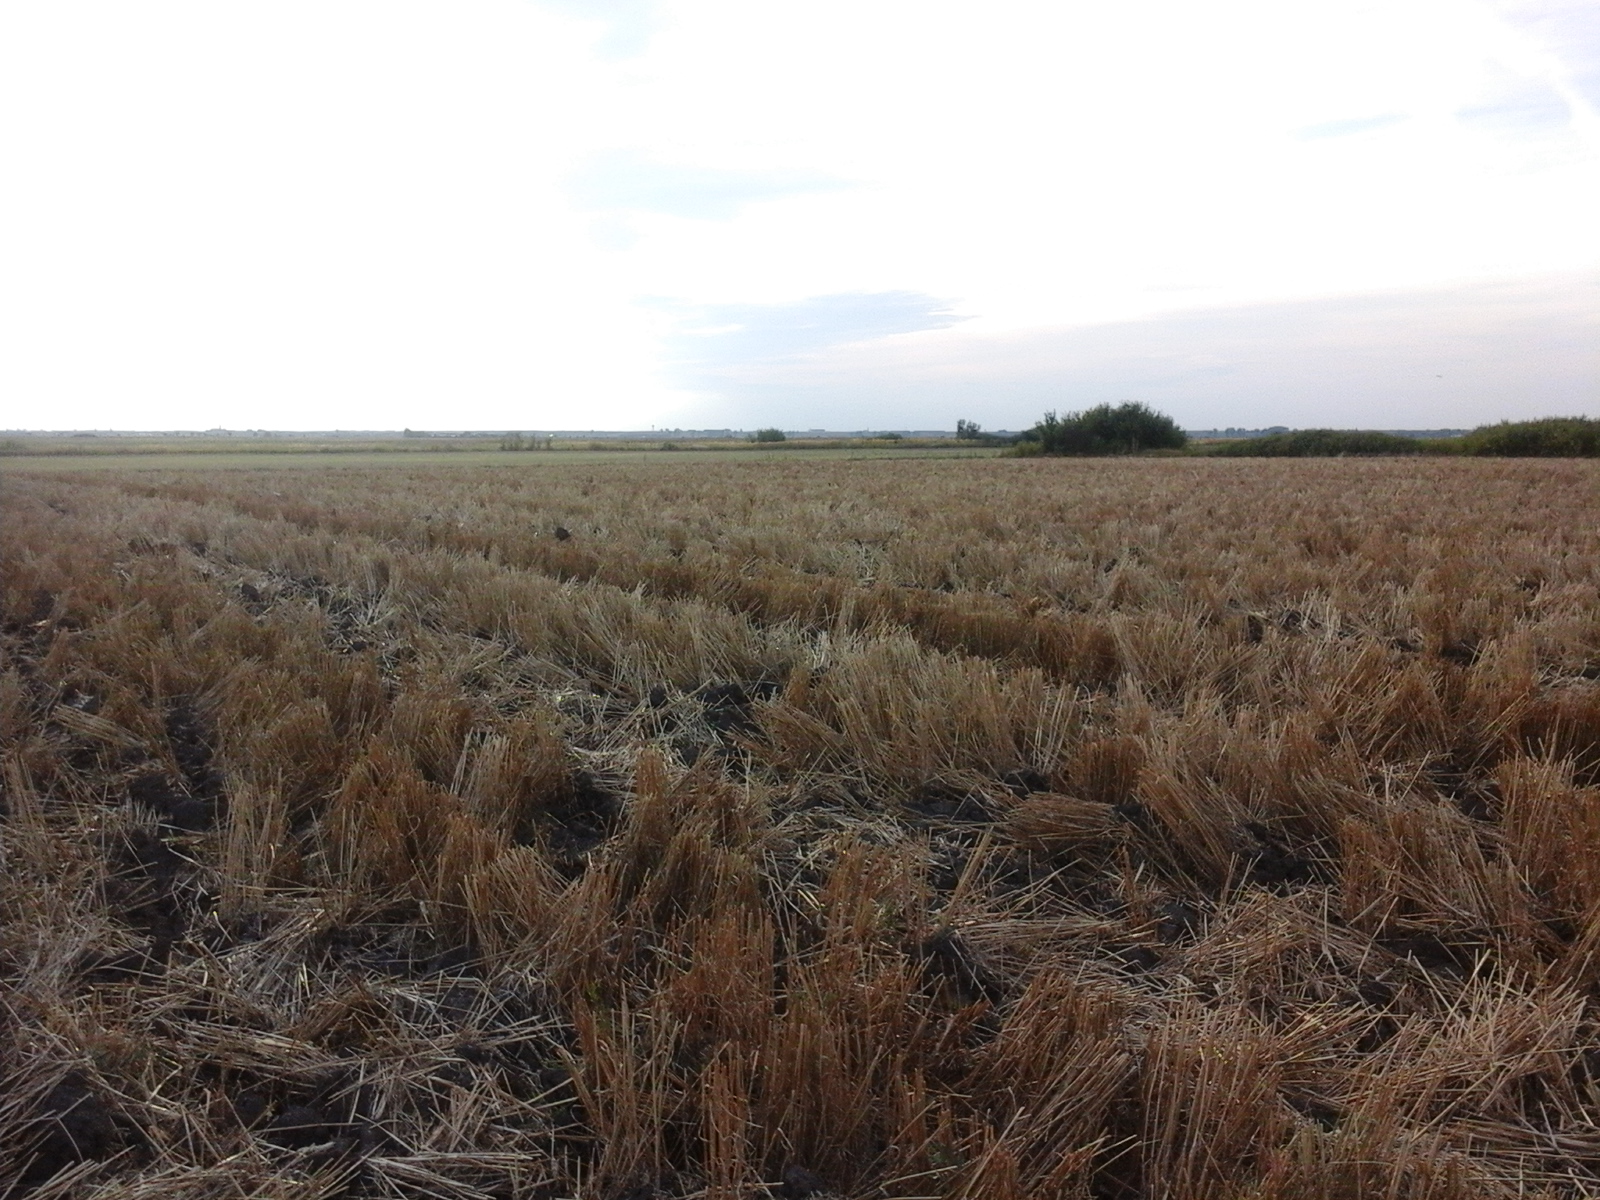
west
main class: Cropland
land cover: Common wheat
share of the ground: 25 - 50 %
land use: Agriculture (excluding fallow land and kitchen gardens)
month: August
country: RO
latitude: 45.2560
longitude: 21.3316
